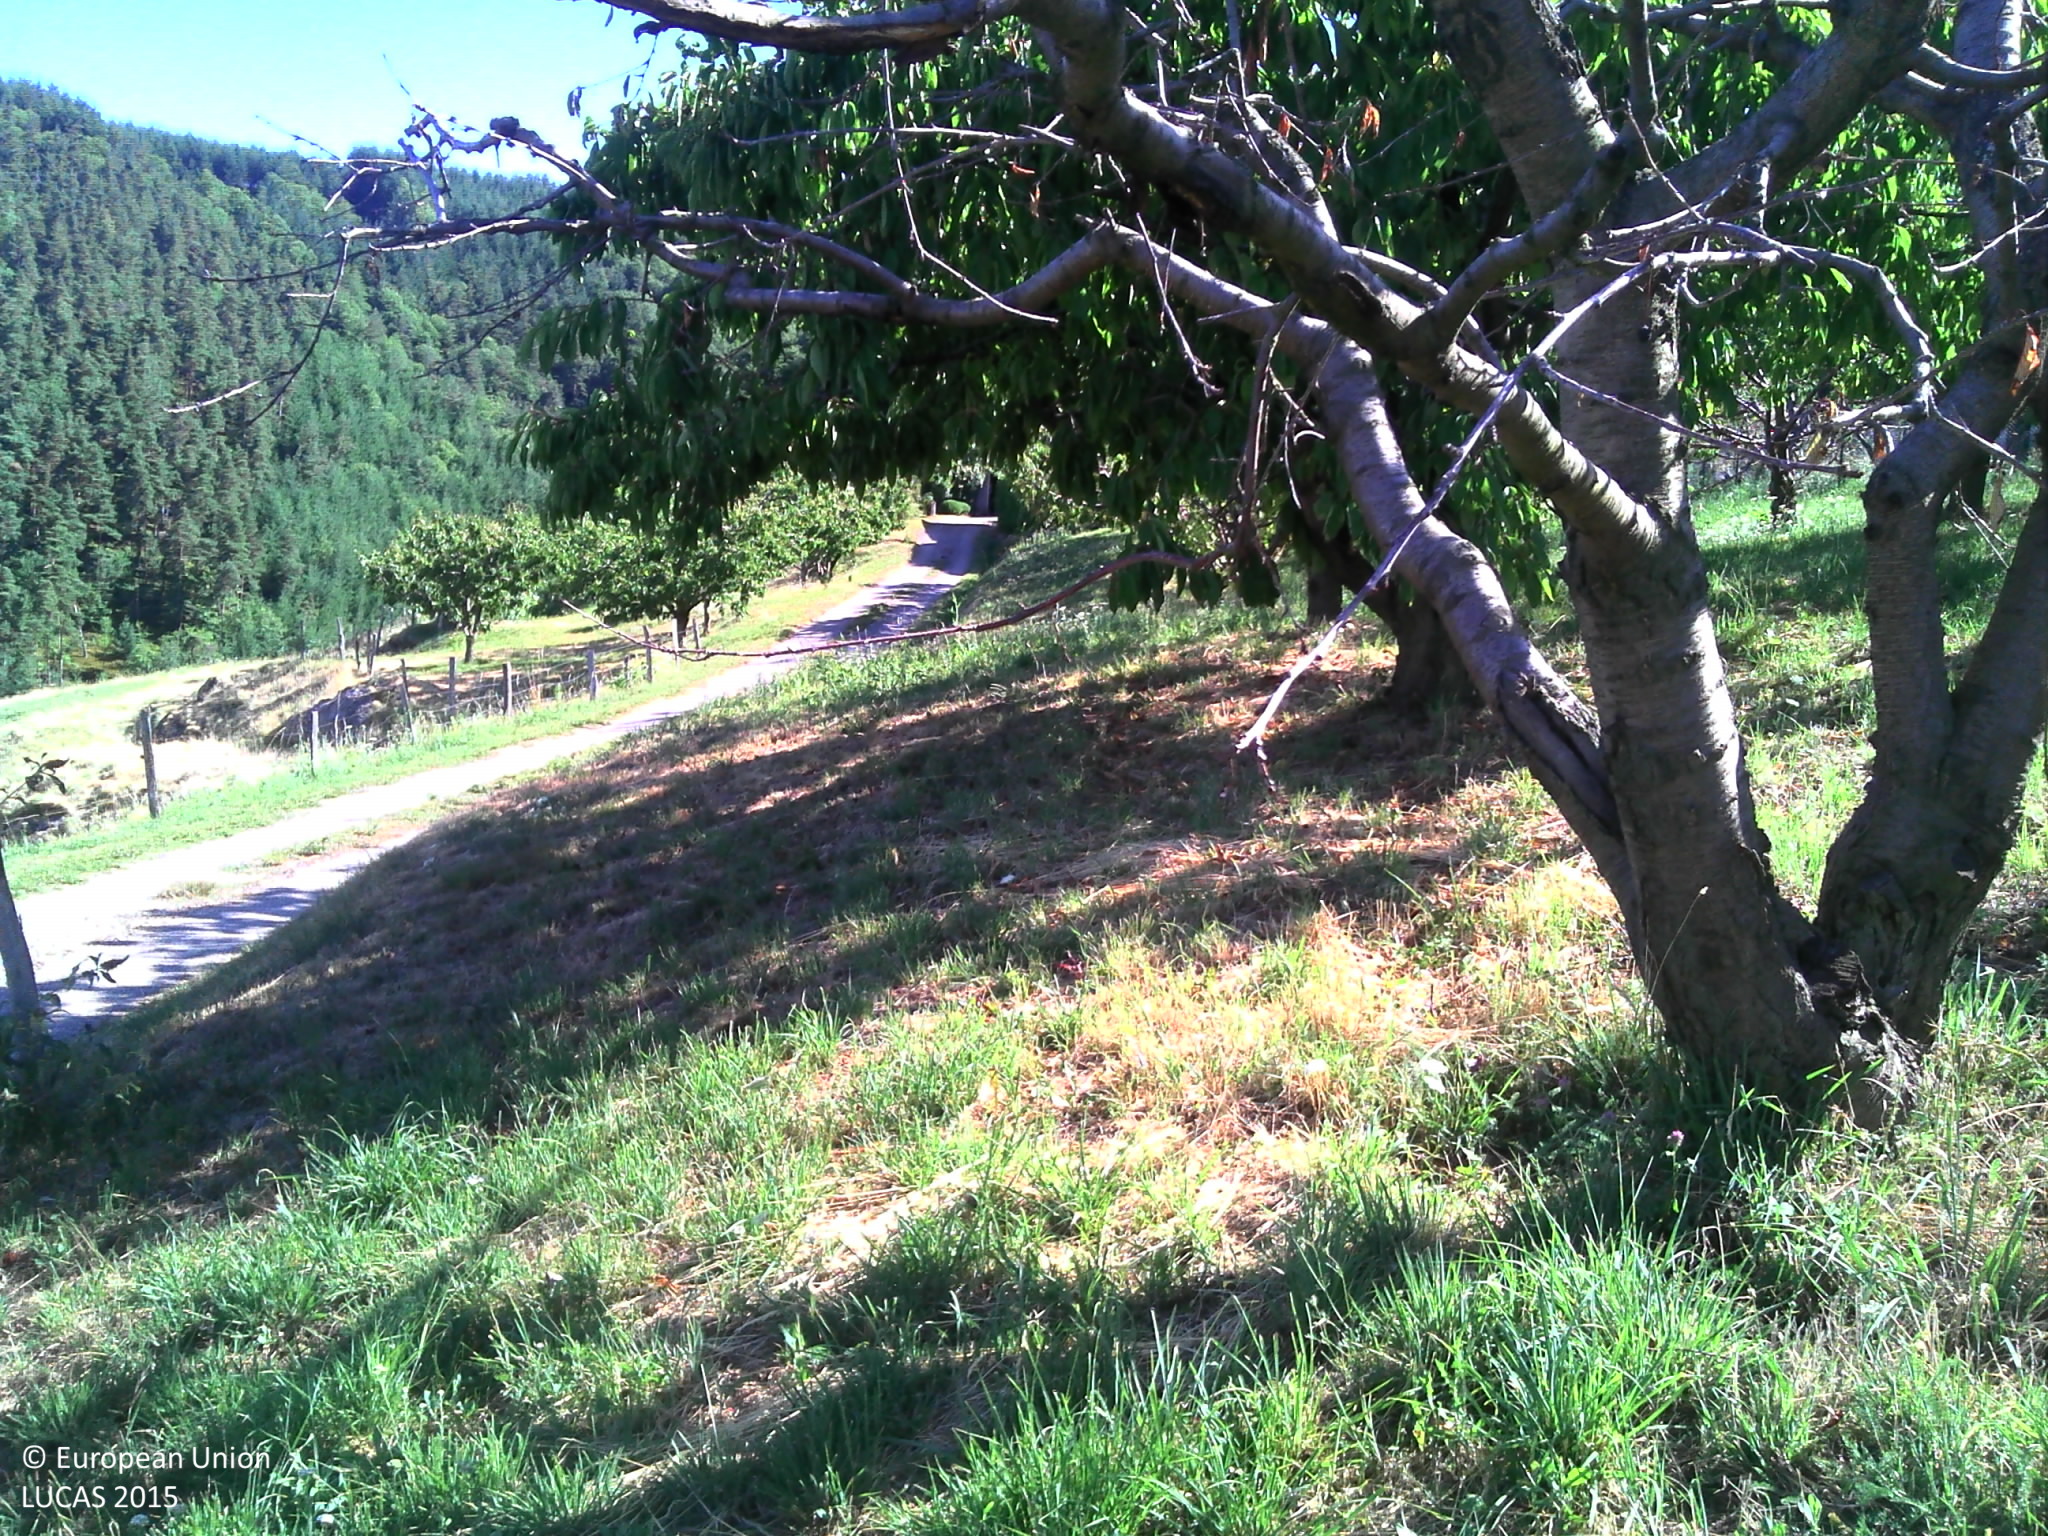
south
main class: Cropland
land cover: Cherry fruit
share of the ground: > 75 %
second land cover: Grassland without tree/shrub cover
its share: > 75 %
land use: Agriculture (excluding fallow land and kitchen gardens)
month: July
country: FR
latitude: 44.9478
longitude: 4.5427
